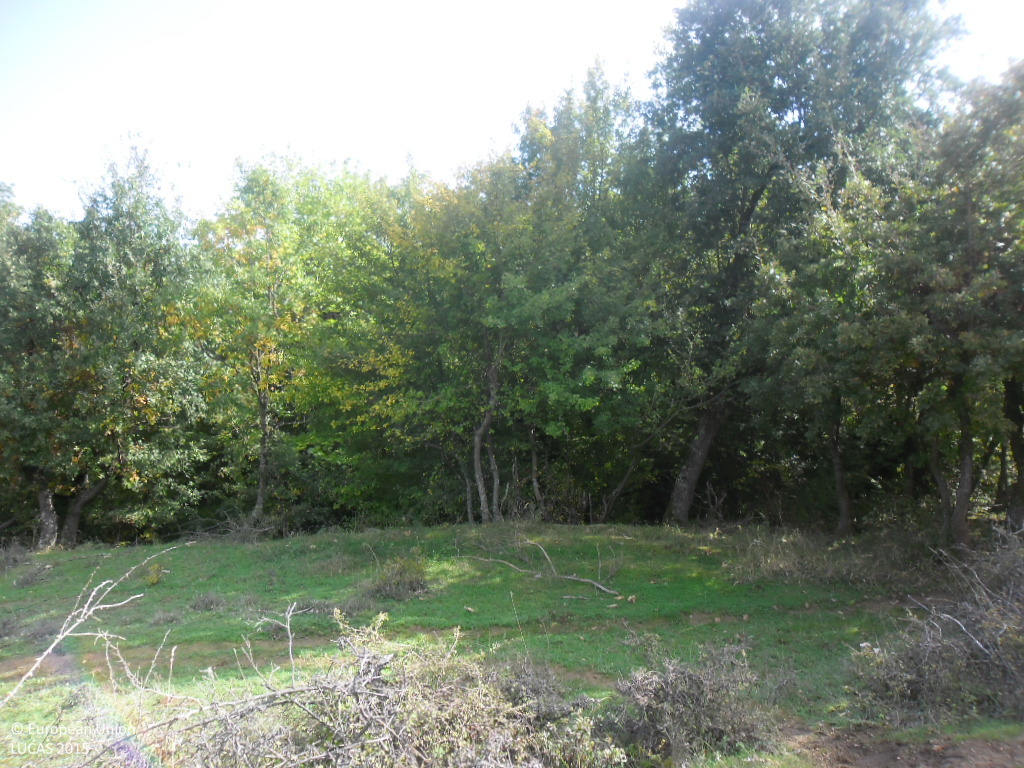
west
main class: Woodland
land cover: Broadleaved woodland
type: mesophytic deciduous forest
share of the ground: > 75 %
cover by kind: broadleaved forest trees 75 %, shrubs 10 %, herbaceous plants 10 %, unconsolidated bare surface 5 %
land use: Forestry
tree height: < 5 m
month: October
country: BG
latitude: 41.5133
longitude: 23.1882
